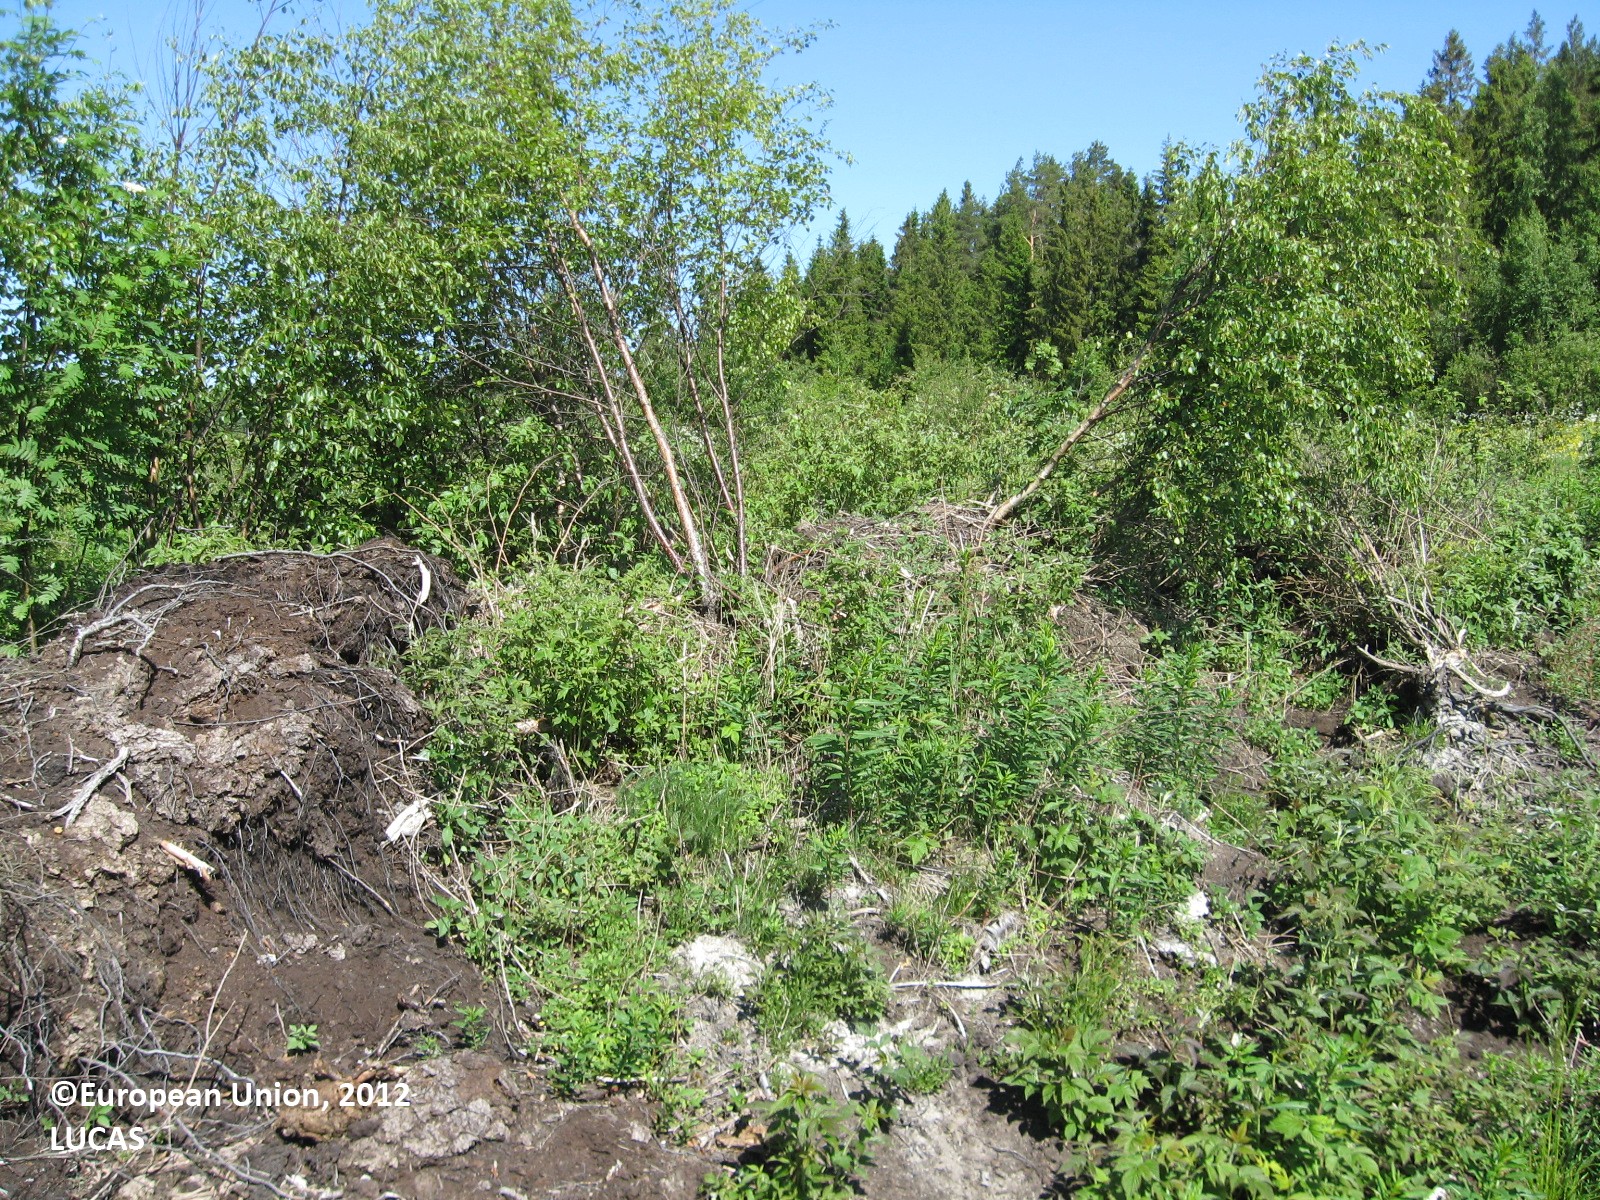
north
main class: Cropland
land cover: Oats
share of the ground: > 75 %
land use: Agriculture (excluding fallow land and kitchen gardens)
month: June
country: FI
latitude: 62.9441
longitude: 21.6484
